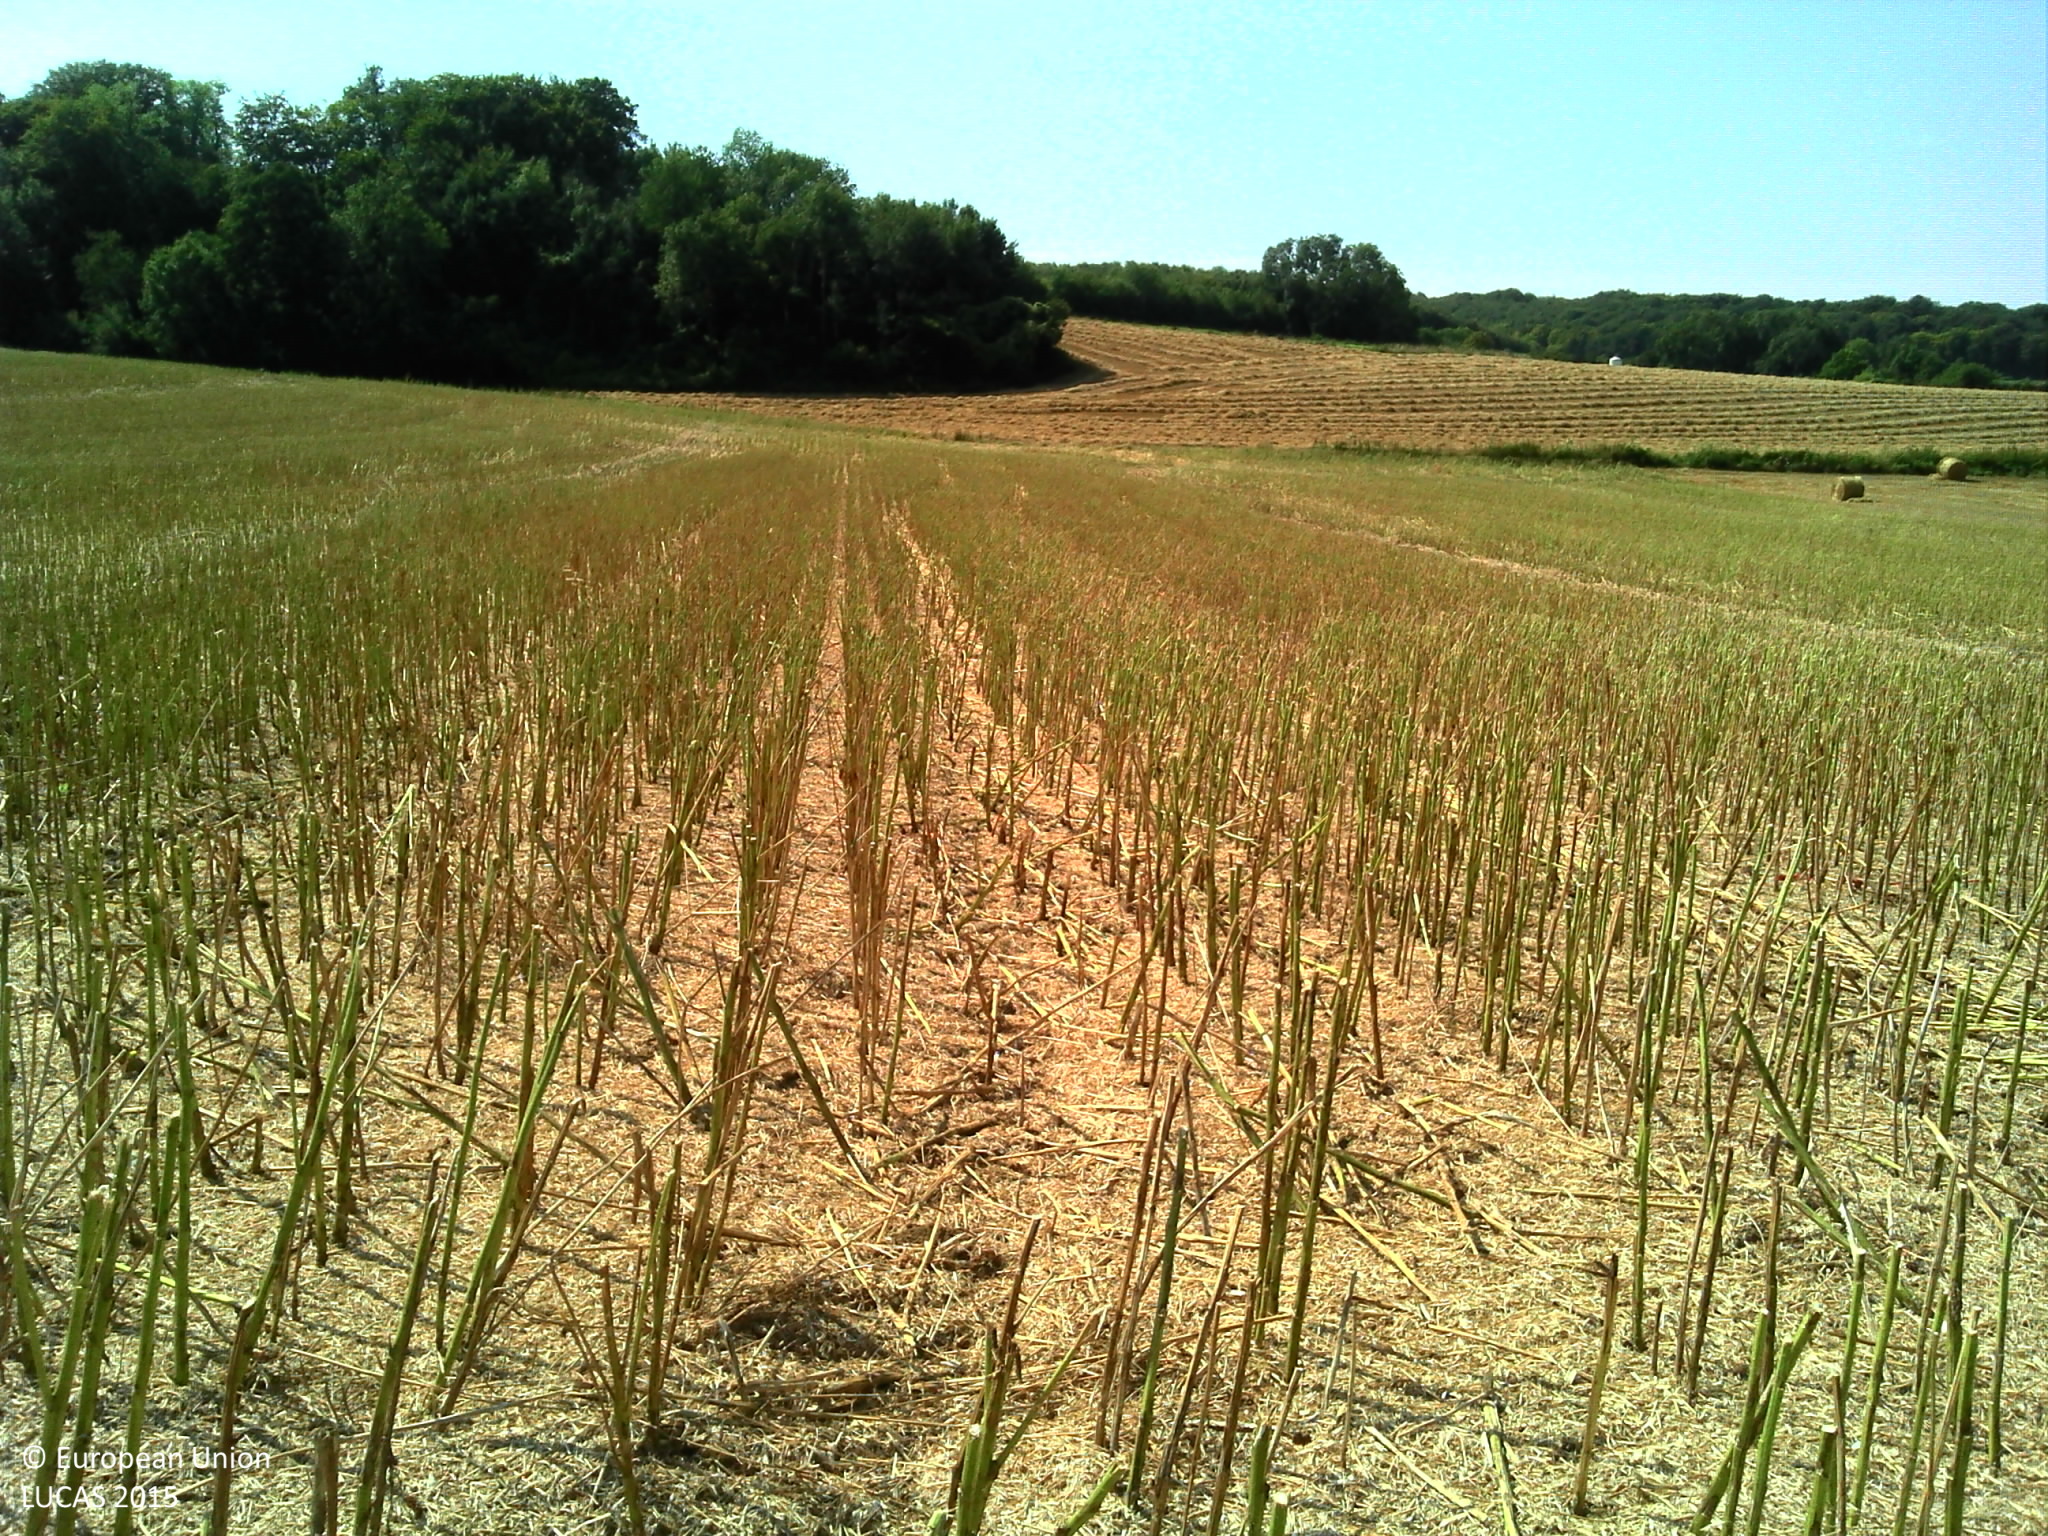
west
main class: Cropland
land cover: Rape and turnip rape
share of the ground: 25 - 50 %
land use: Agriculture (excluding fallow land and kitchen gardens)
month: August
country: FR
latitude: 50.7723
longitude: 2.0293
